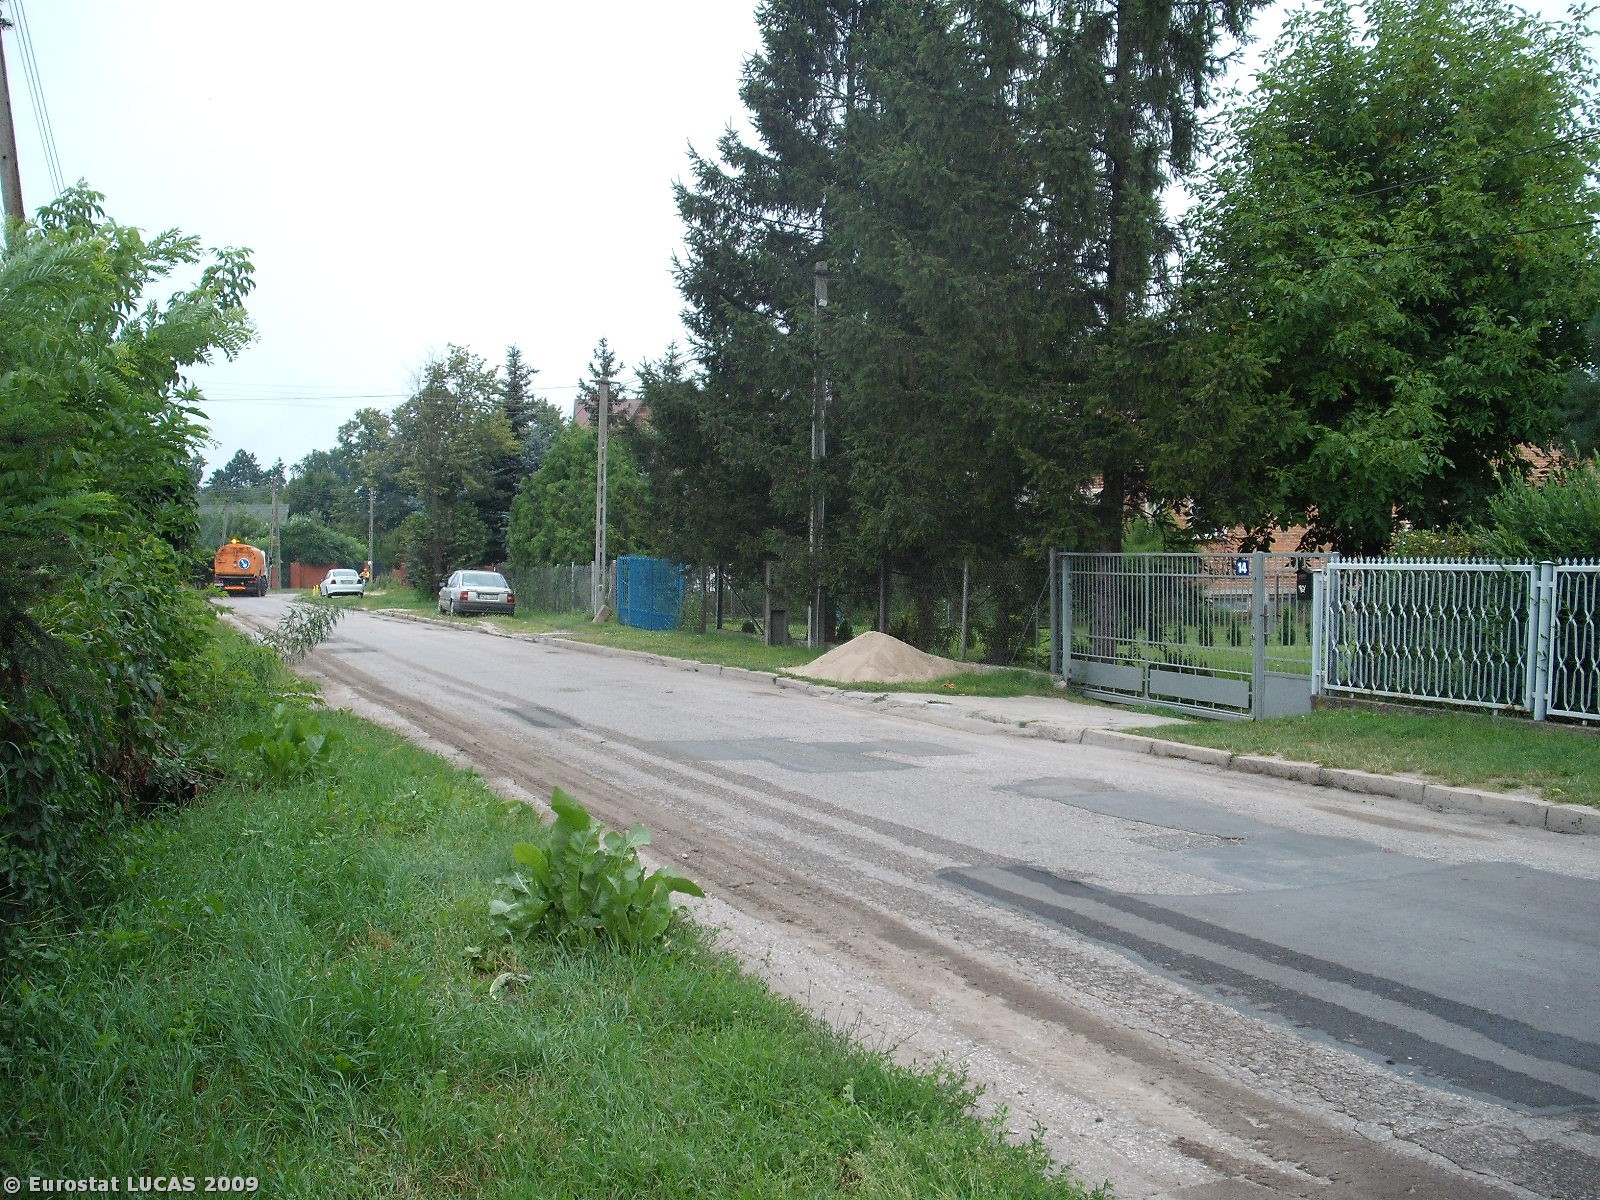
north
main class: Cropland
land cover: Cherry fruit
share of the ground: 25 - 50 %
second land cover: Grassland with sparse tree/shrub cover
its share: > 75 %
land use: Agriculture (excluding fallow land and kitchen gardens)
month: August
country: PL
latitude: 51.9892
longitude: 21.2165
